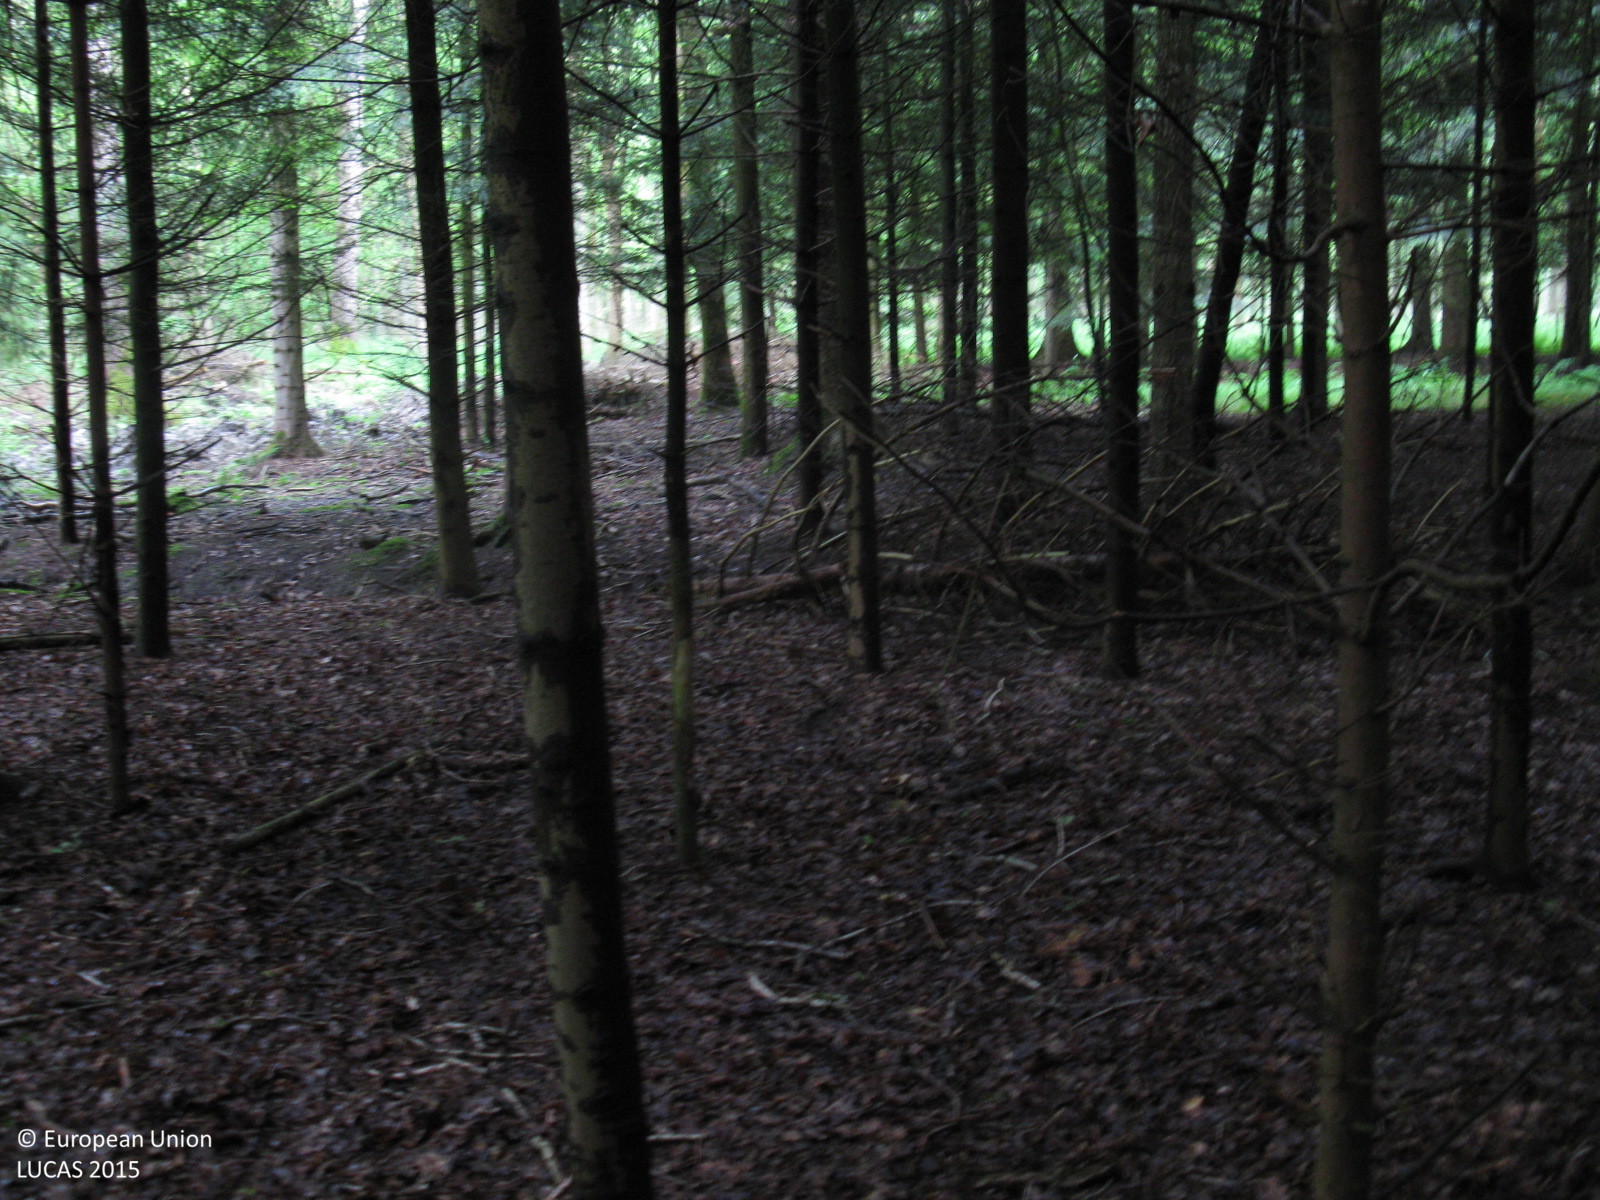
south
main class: Woodland
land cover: Spruce dominated mixed woodland
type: hemiboreal forest and nemoral coniferous forest and mixed broadleaved-coniferous forest
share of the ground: > 75 %
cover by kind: coniferous forest trees 70 %, broadleaved forest trees 30 %
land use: Forestry
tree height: > 5 m
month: June
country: DE
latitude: 53.6228
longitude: 7.2641
